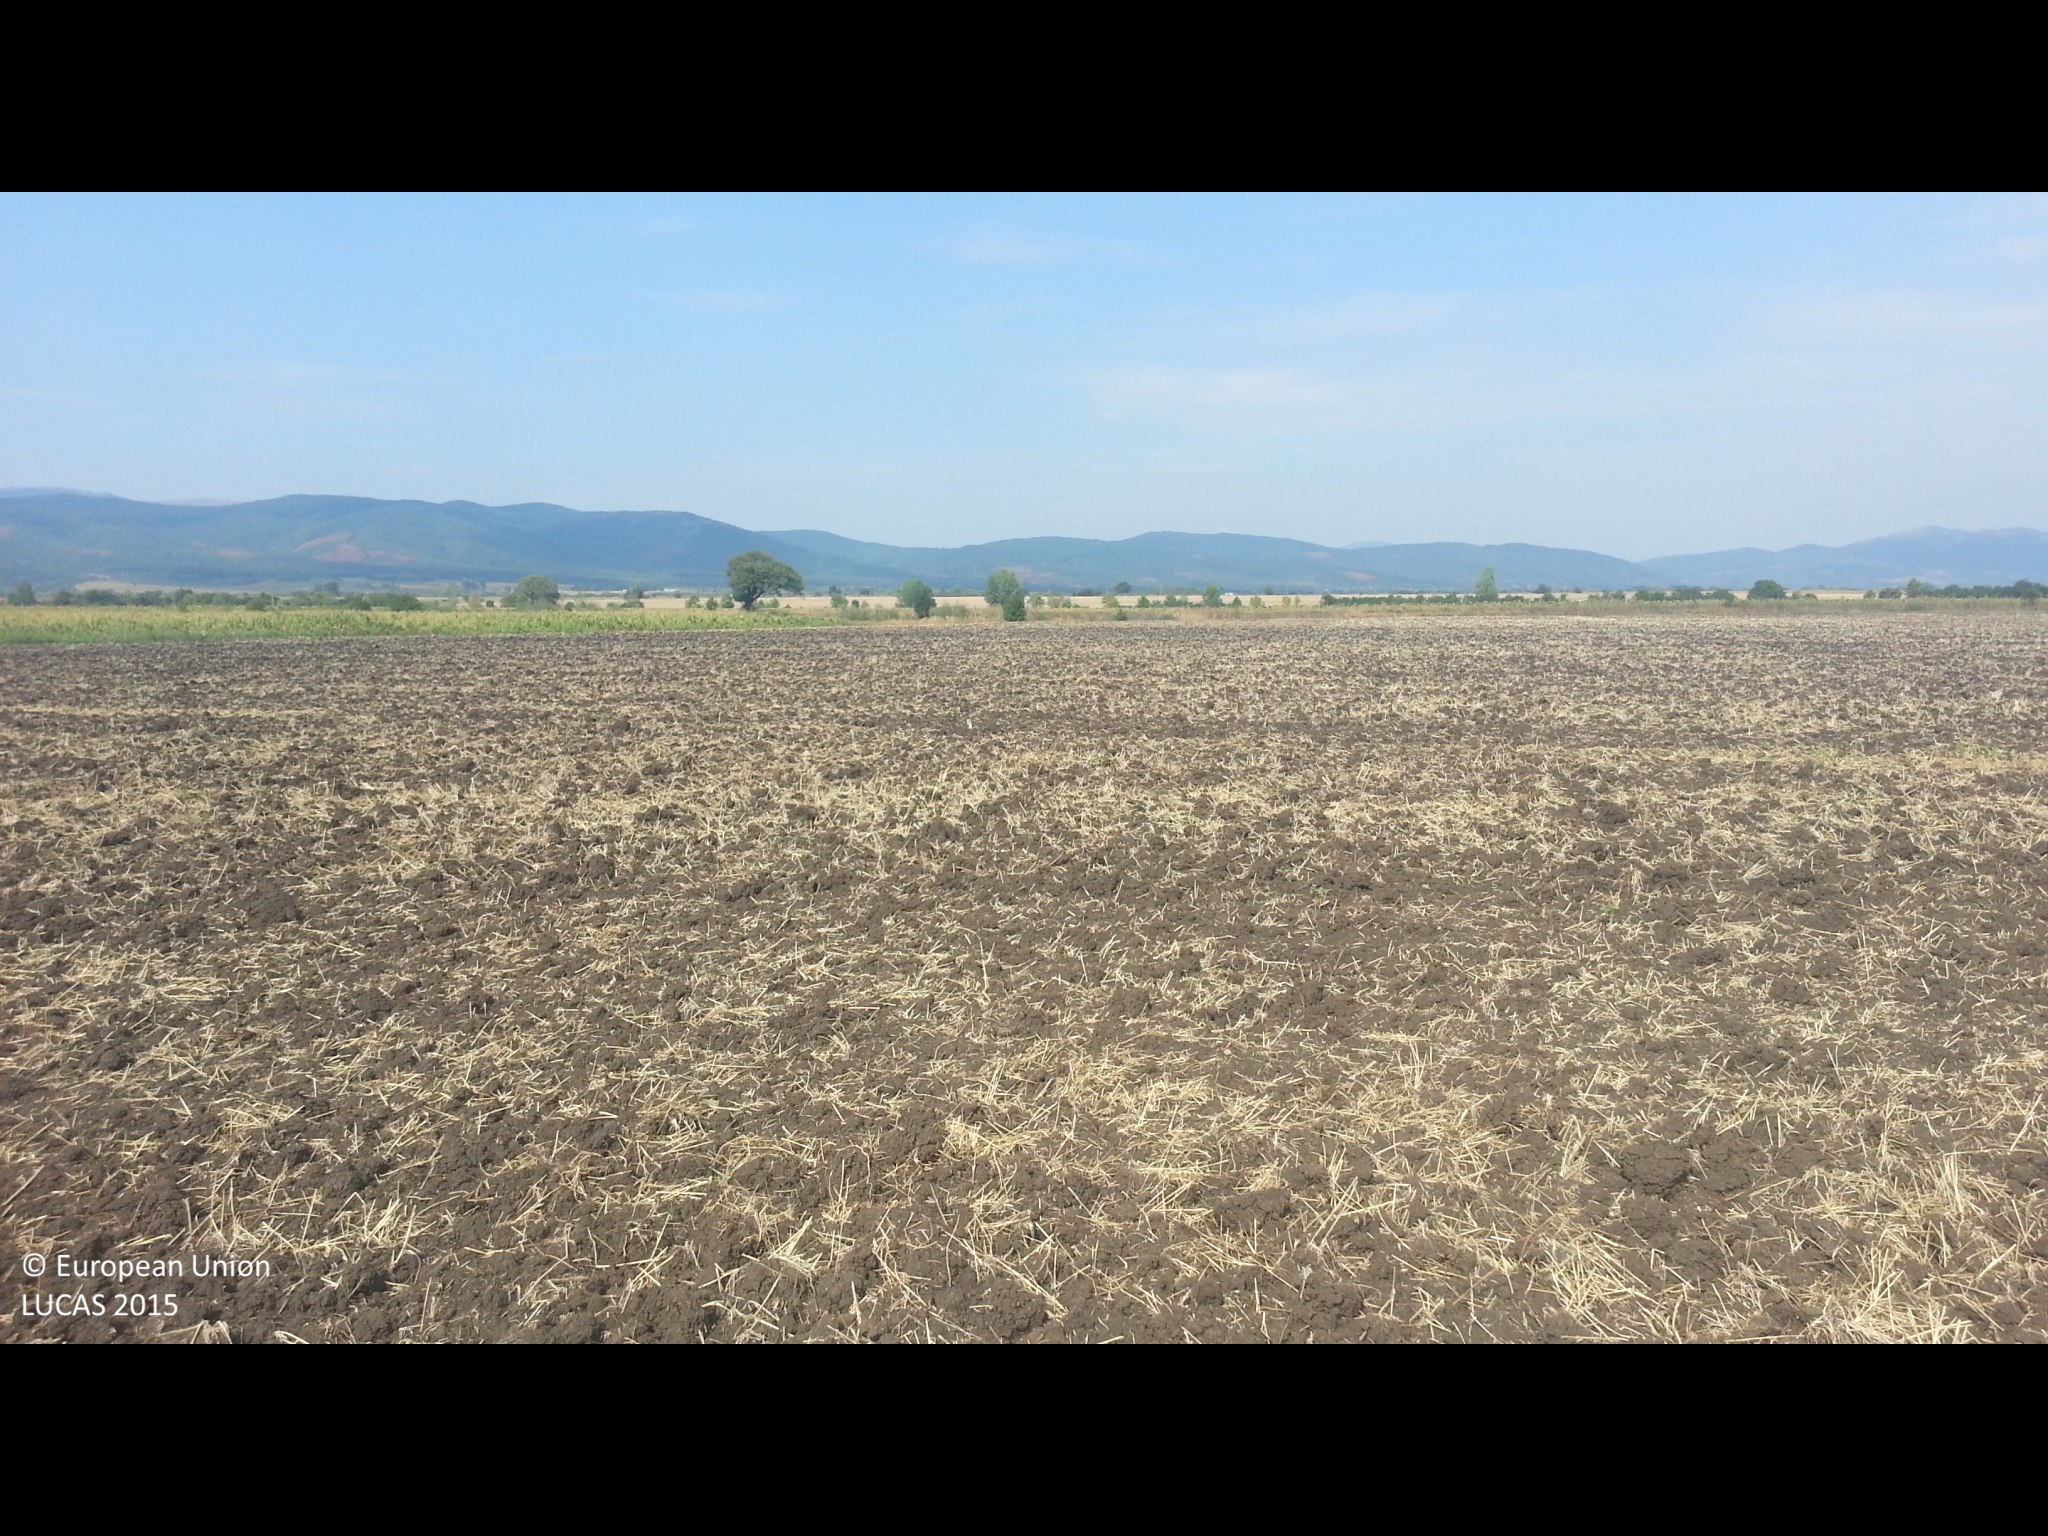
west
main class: Cropland
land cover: Common wheat
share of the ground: < 10 %
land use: Agriculture (excluding fallow land and kitchen gardens)
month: August
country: BG
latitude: 42.4461
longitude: 22.9014
